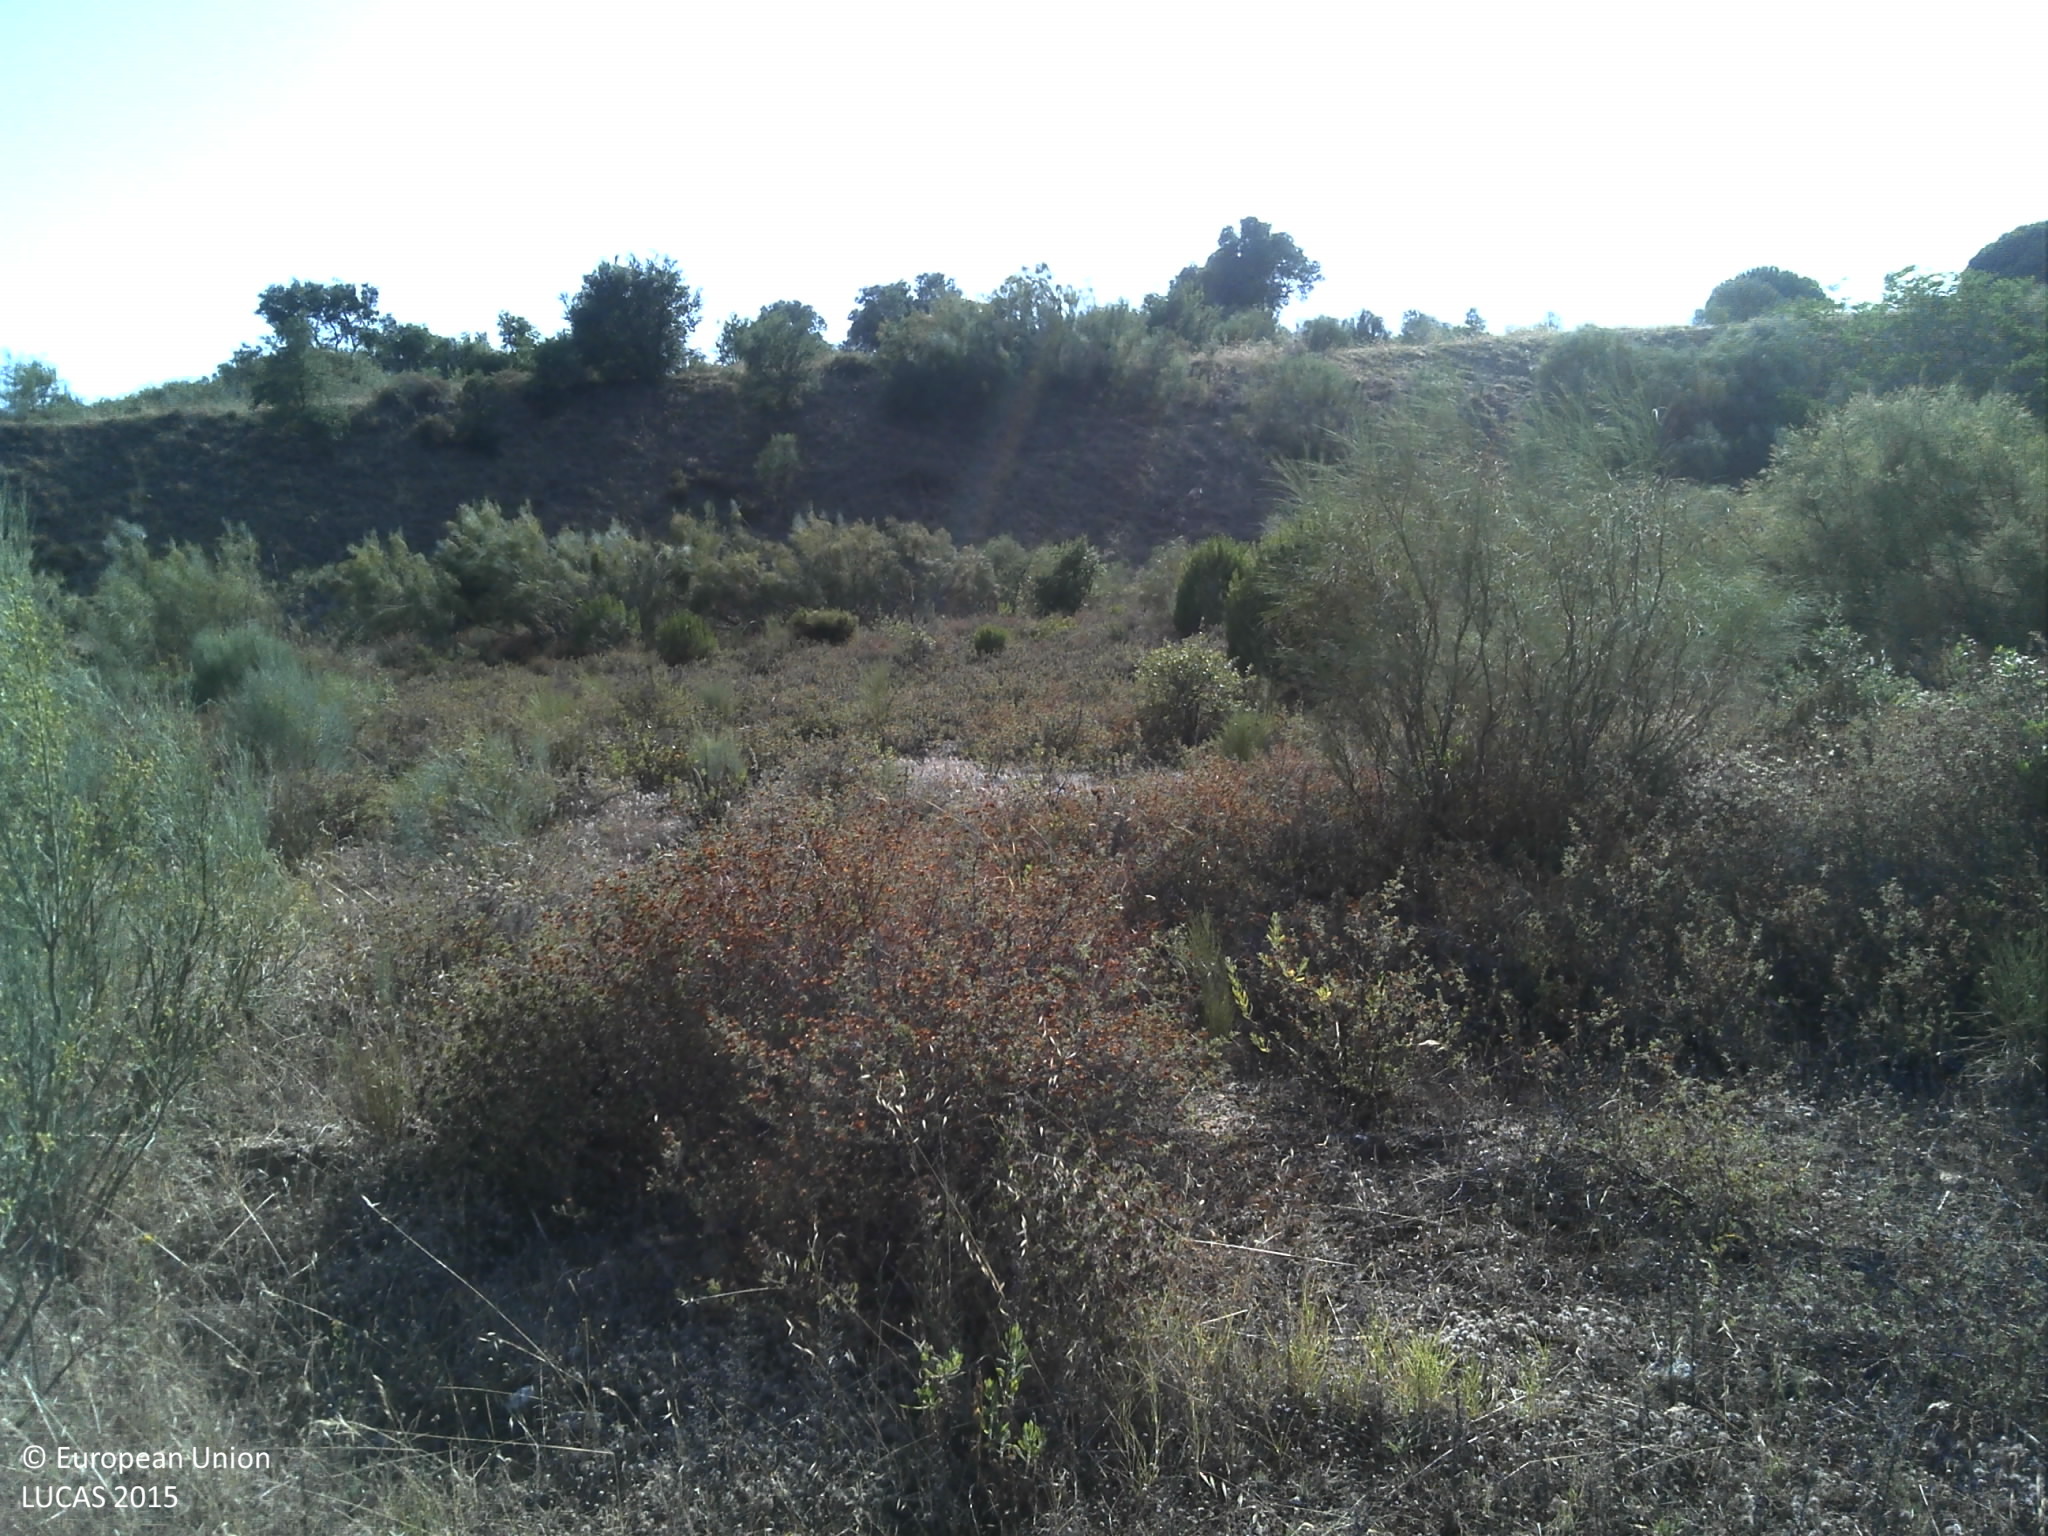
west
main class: Grassland
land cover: Grassland with sparse tree/shrub cover
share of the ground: 25 - 50 %
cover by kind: unconsolidated bare surface 60 %, herbaceous plants 30 %, broadleaved forest trees 5 %, shrubs 5 %
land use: Abandoned areas
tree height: < 5 m
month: June
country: PT
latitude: 38.6337
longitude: -9.0839
